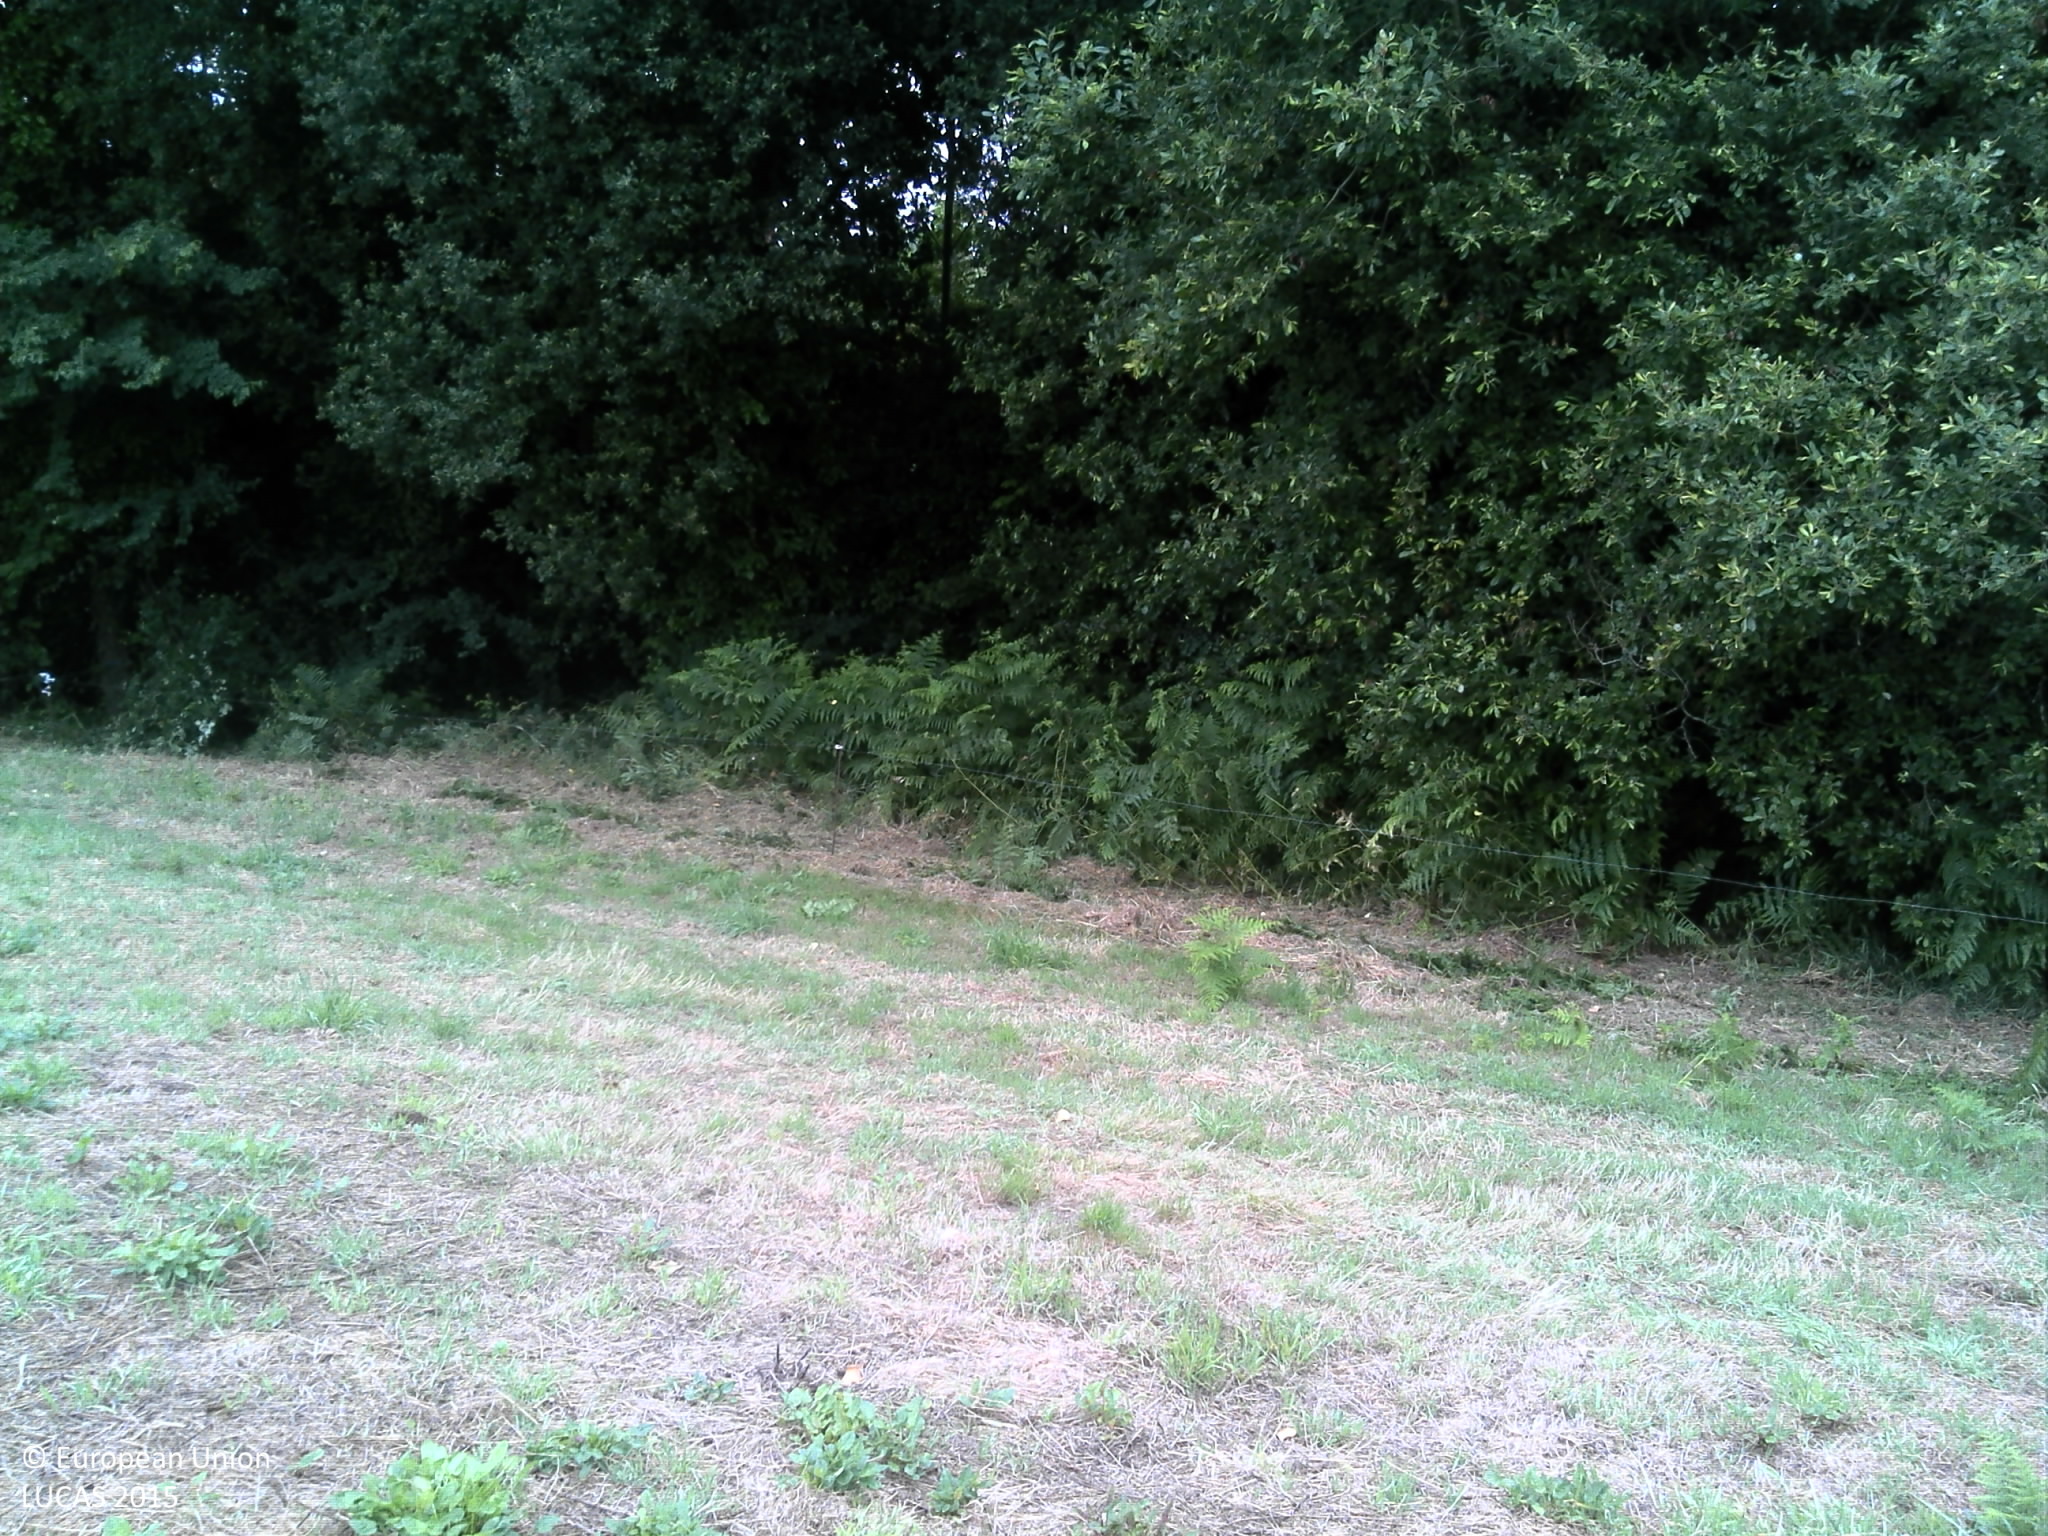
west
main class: Grassland
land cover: Grassland without tree/shrub cover
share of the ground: > 75 %
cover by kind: herbaceous plants 100 %
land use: Agriculture (excluding fallow land and kitchen gardens)
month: July
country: FR
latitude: 48.0488
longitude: -4.1897
